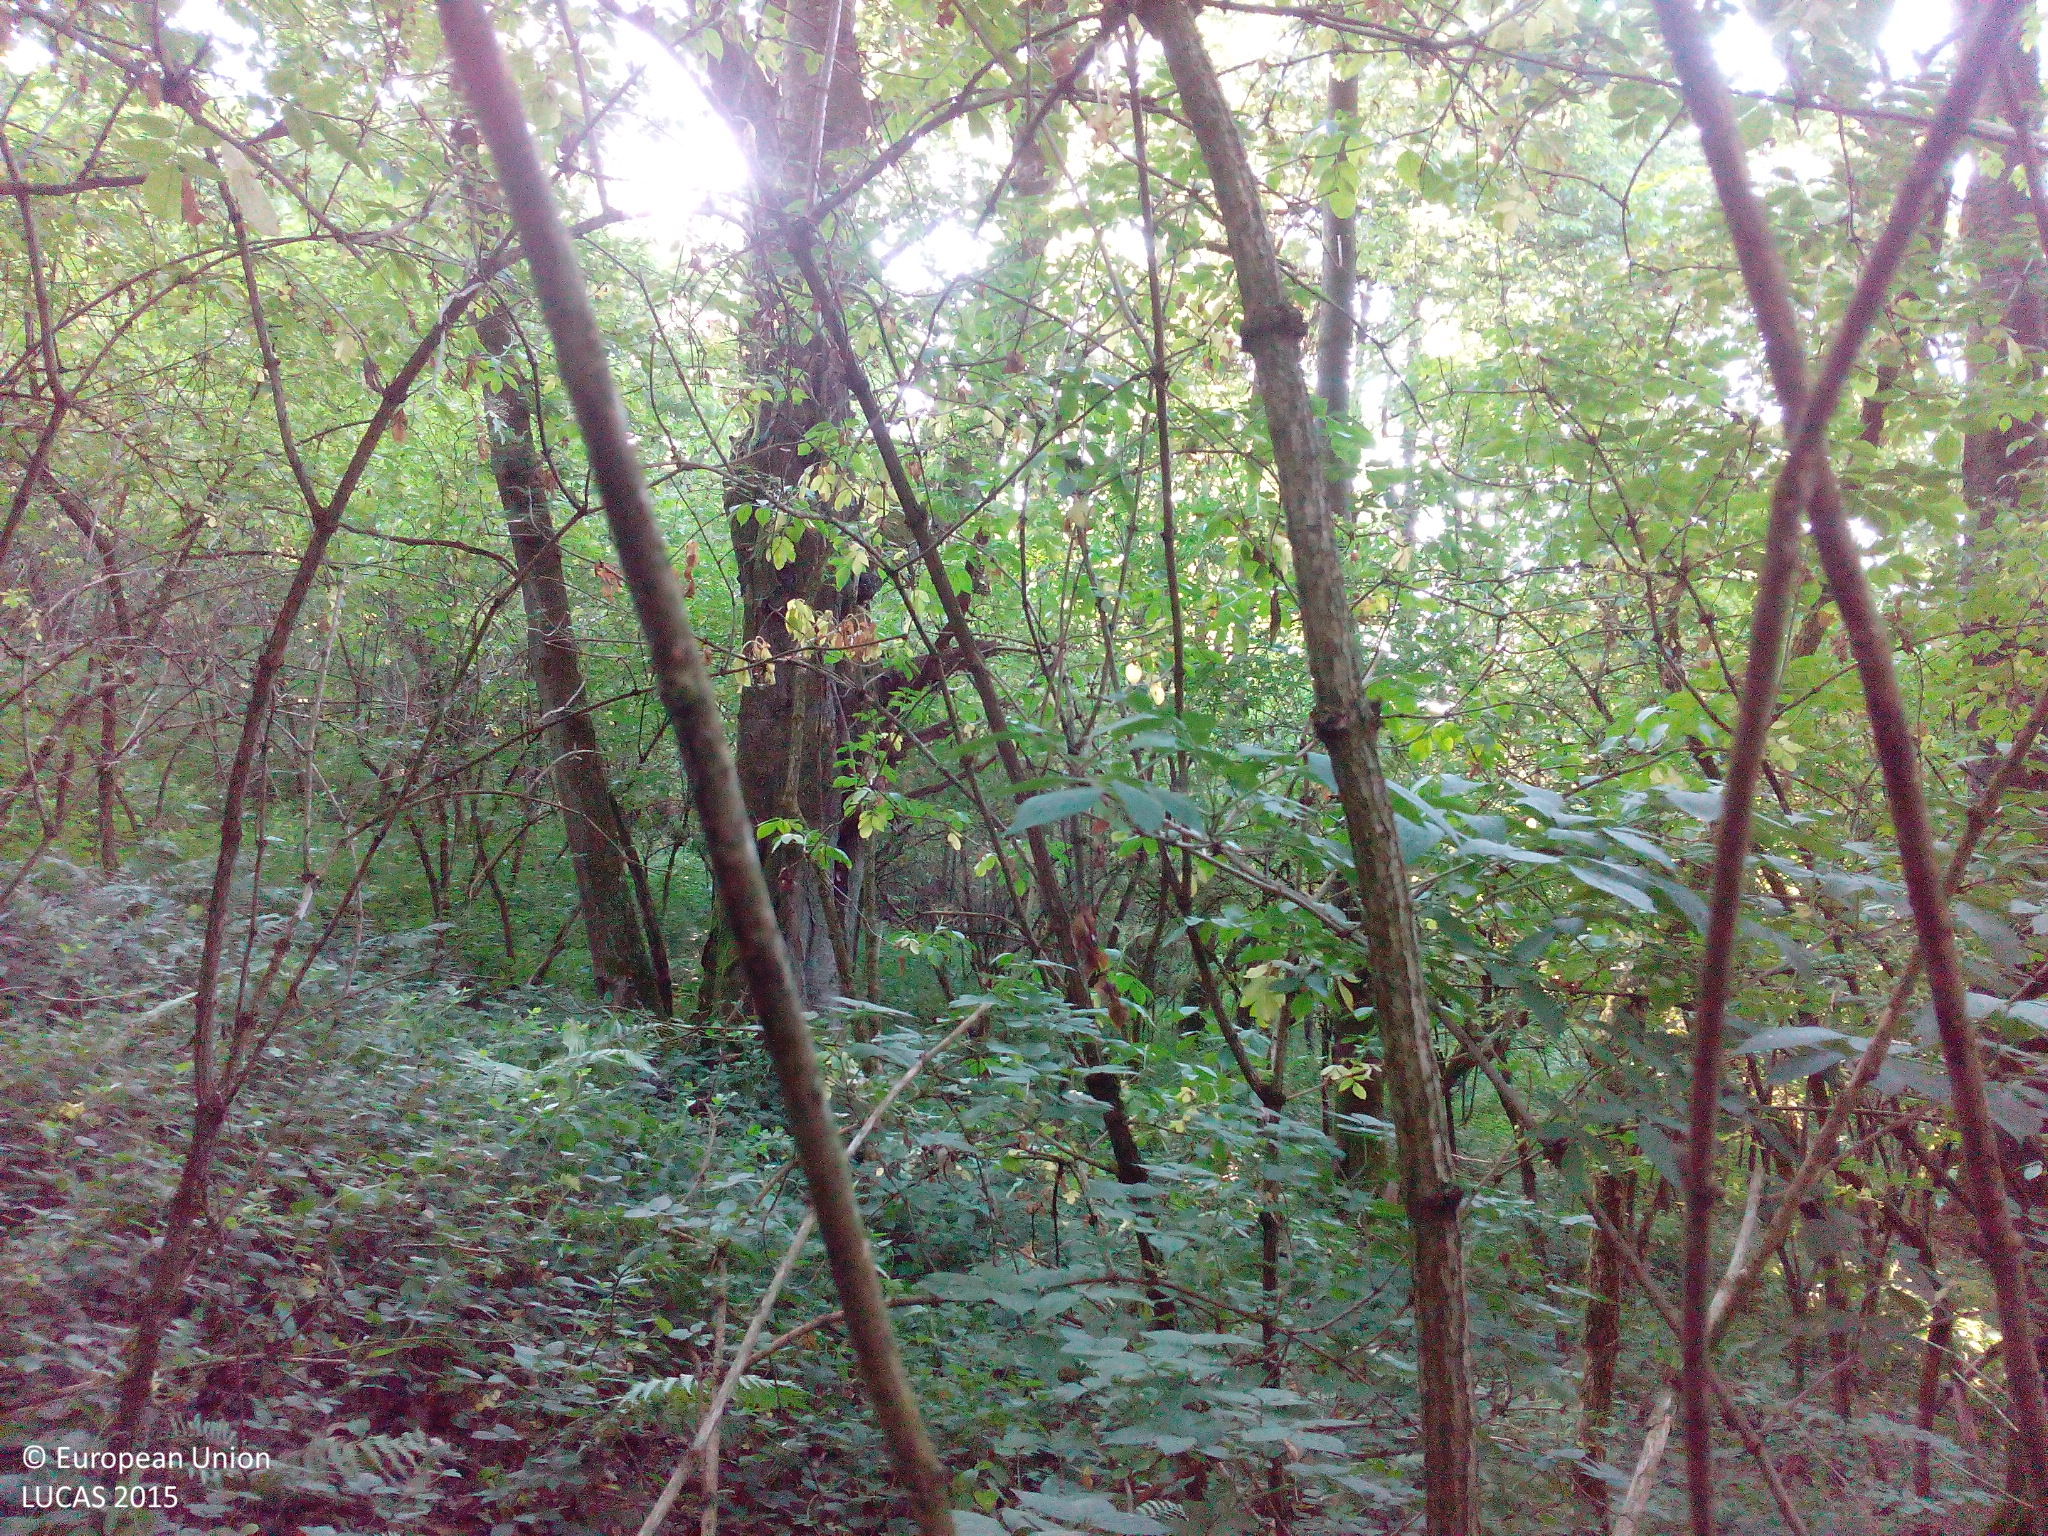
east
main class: Woodland
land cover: Broadleaved woodland
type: mesophytic deciduous forest
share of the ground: 50 - 75 %
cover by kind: broadleaved forest trees 70 %, shrubs 10 %, herbaceous plants 10 %, unconsolidated bare surface 10 %
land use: Forestry
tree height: > 5 m
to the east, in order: Broadleaved woodland; Spruce dominated mixed woodland
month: July
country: DE
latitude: 49.2946
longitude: 7.5667
